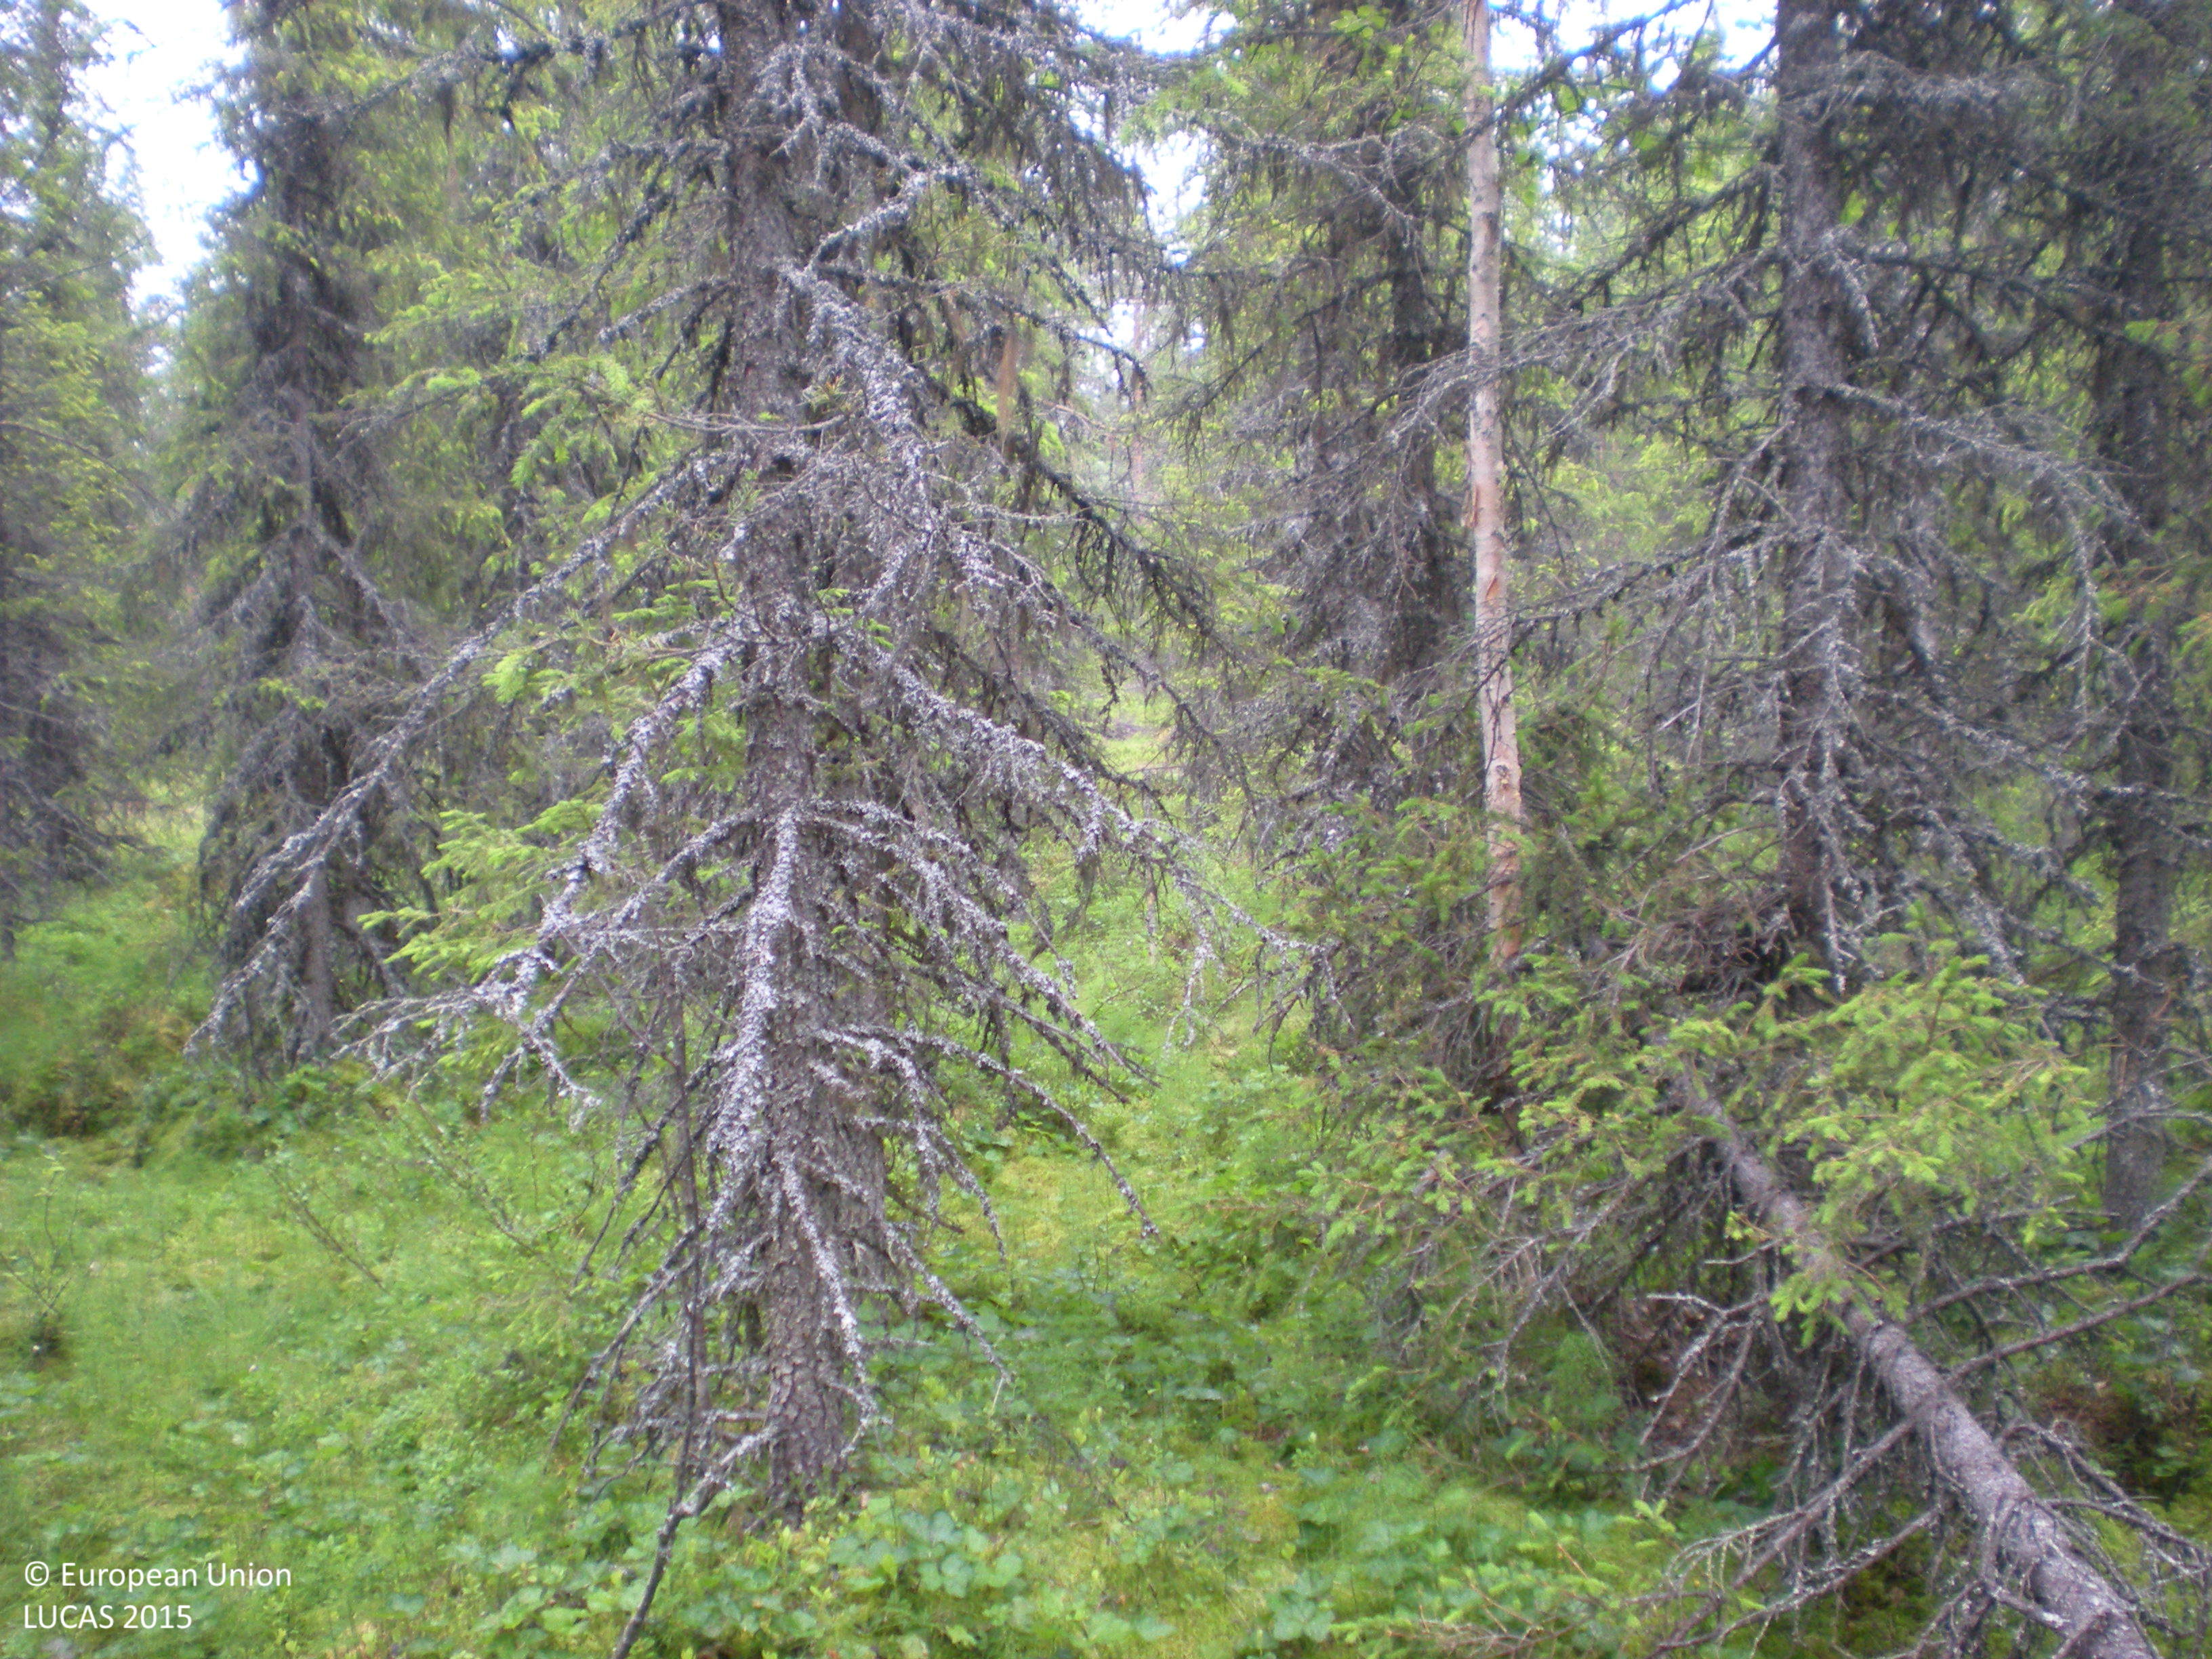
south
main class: Woodland
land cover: Spruce dominated coniferous woodland
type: boreal forest
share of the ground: > 75 %
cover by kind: coniferous forest trees 75 %, lichens and mosses 15 %, herbaceous plants 10 %
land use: Forestry
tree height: > 5 m
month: July
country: SE
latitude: 65.5237
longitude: 17.9845
